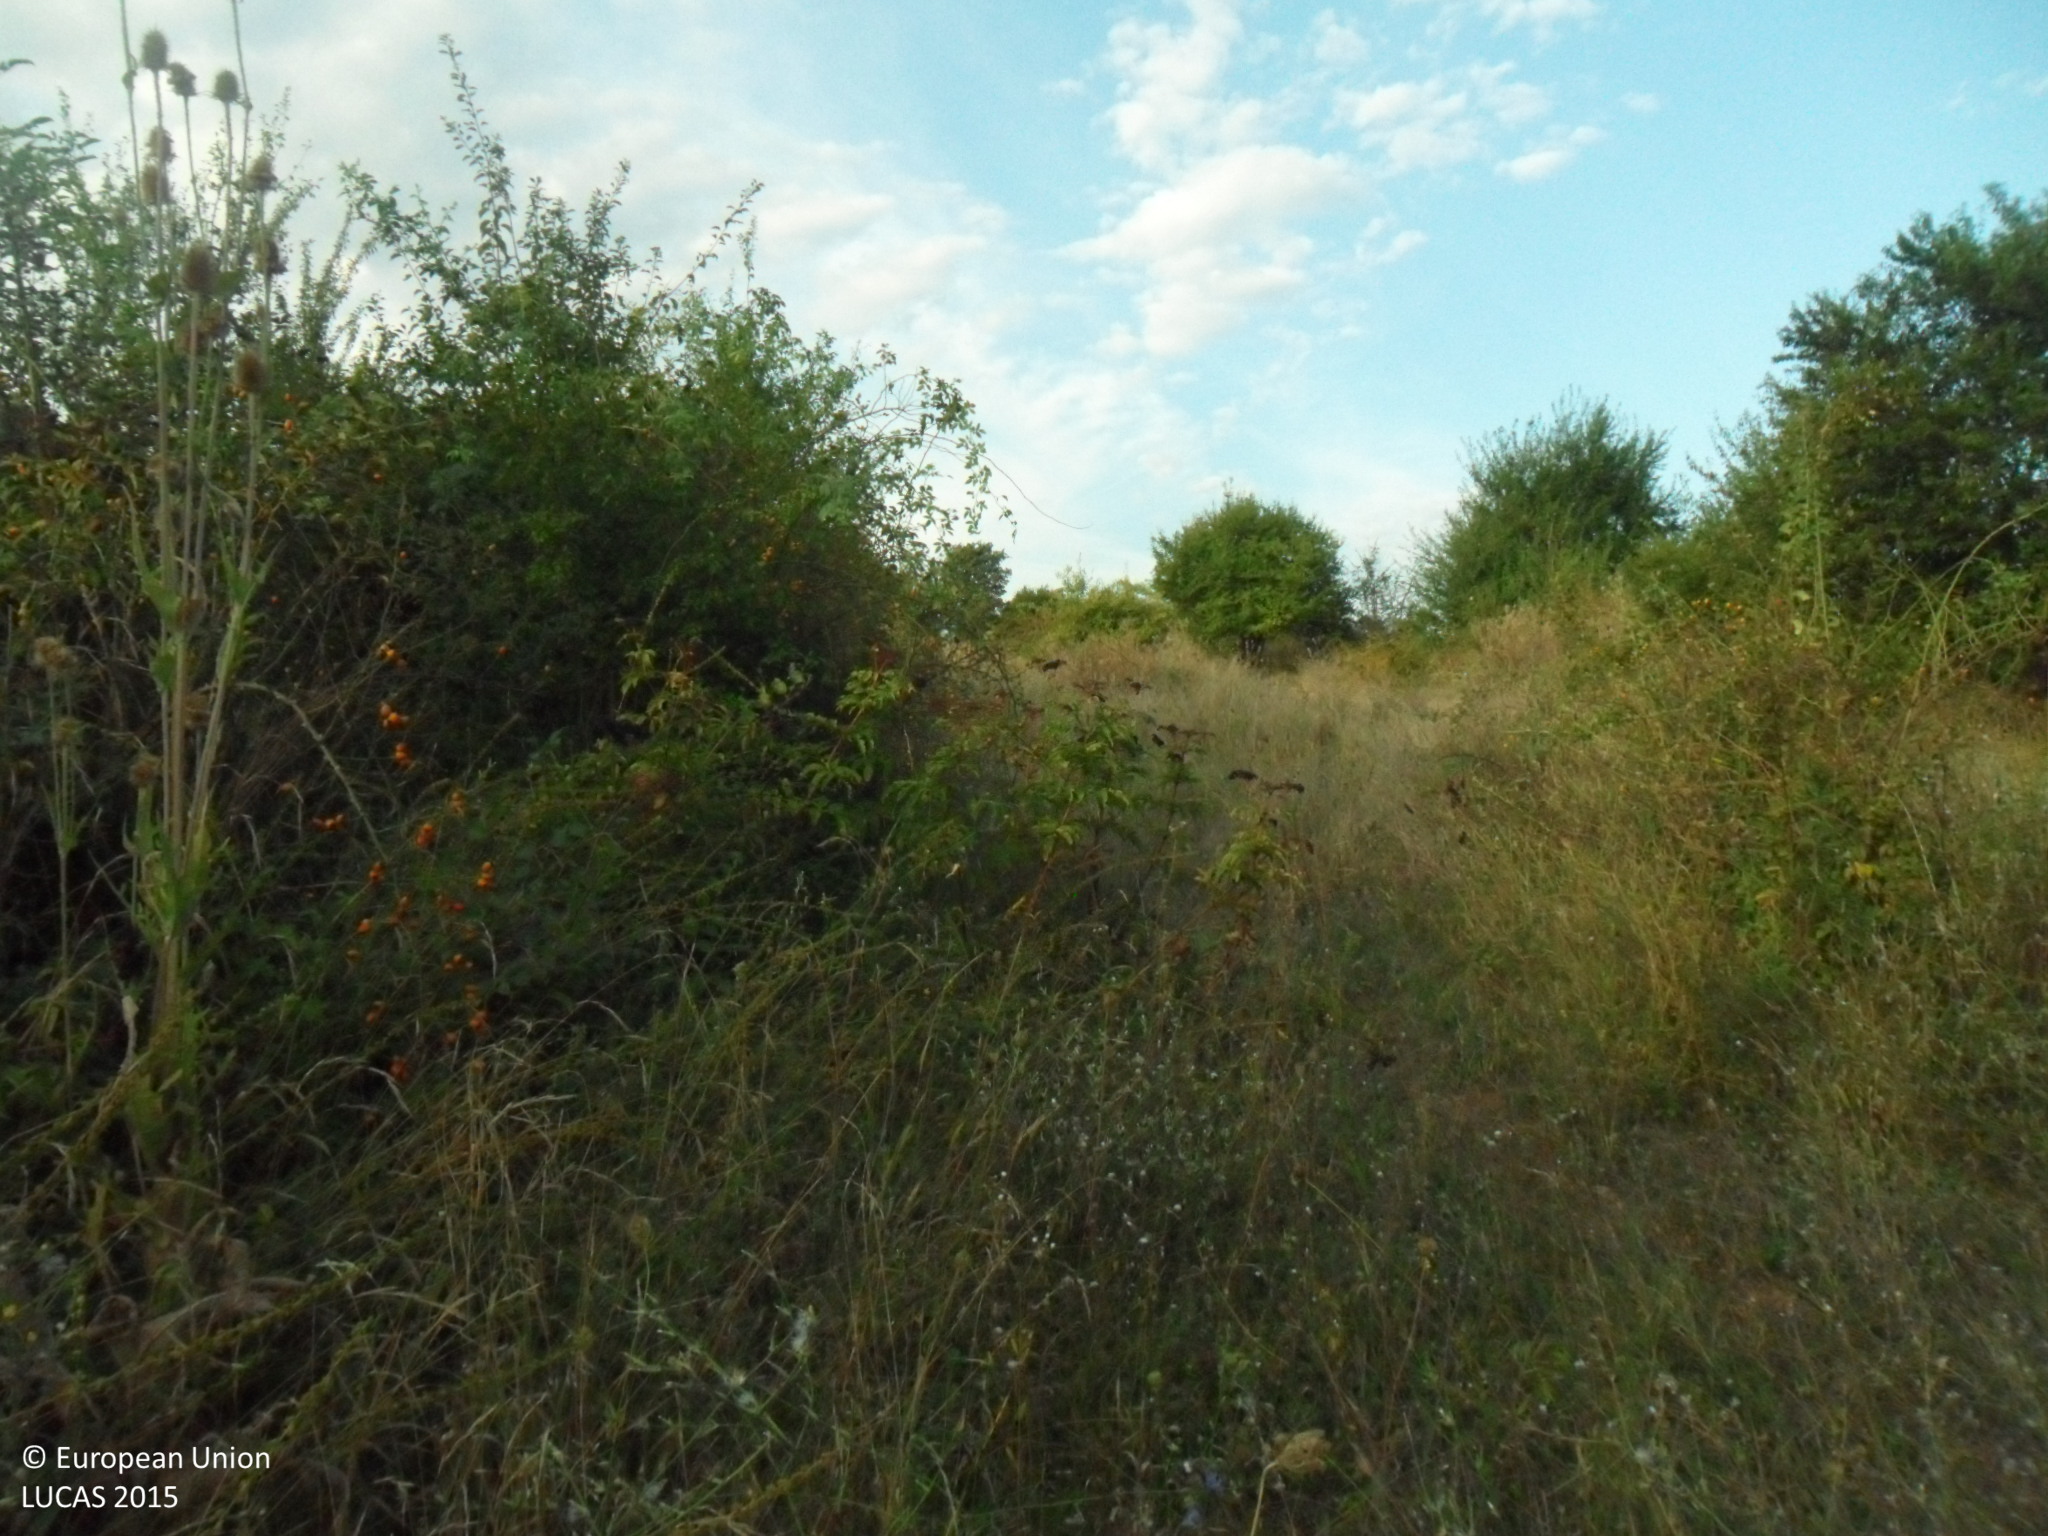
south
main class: Shrubland
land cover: Shrubland with sparse tree cover
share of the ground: > 75 %
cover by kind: shrubs 80 %, herbaceous plants 15 %, broadleaved forest trees 5 %
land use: Agriculture (excluding fallow land and kitchen gardens)
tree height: < 5 m
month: September
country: BG
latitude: 43.6289
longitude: 26.2492
